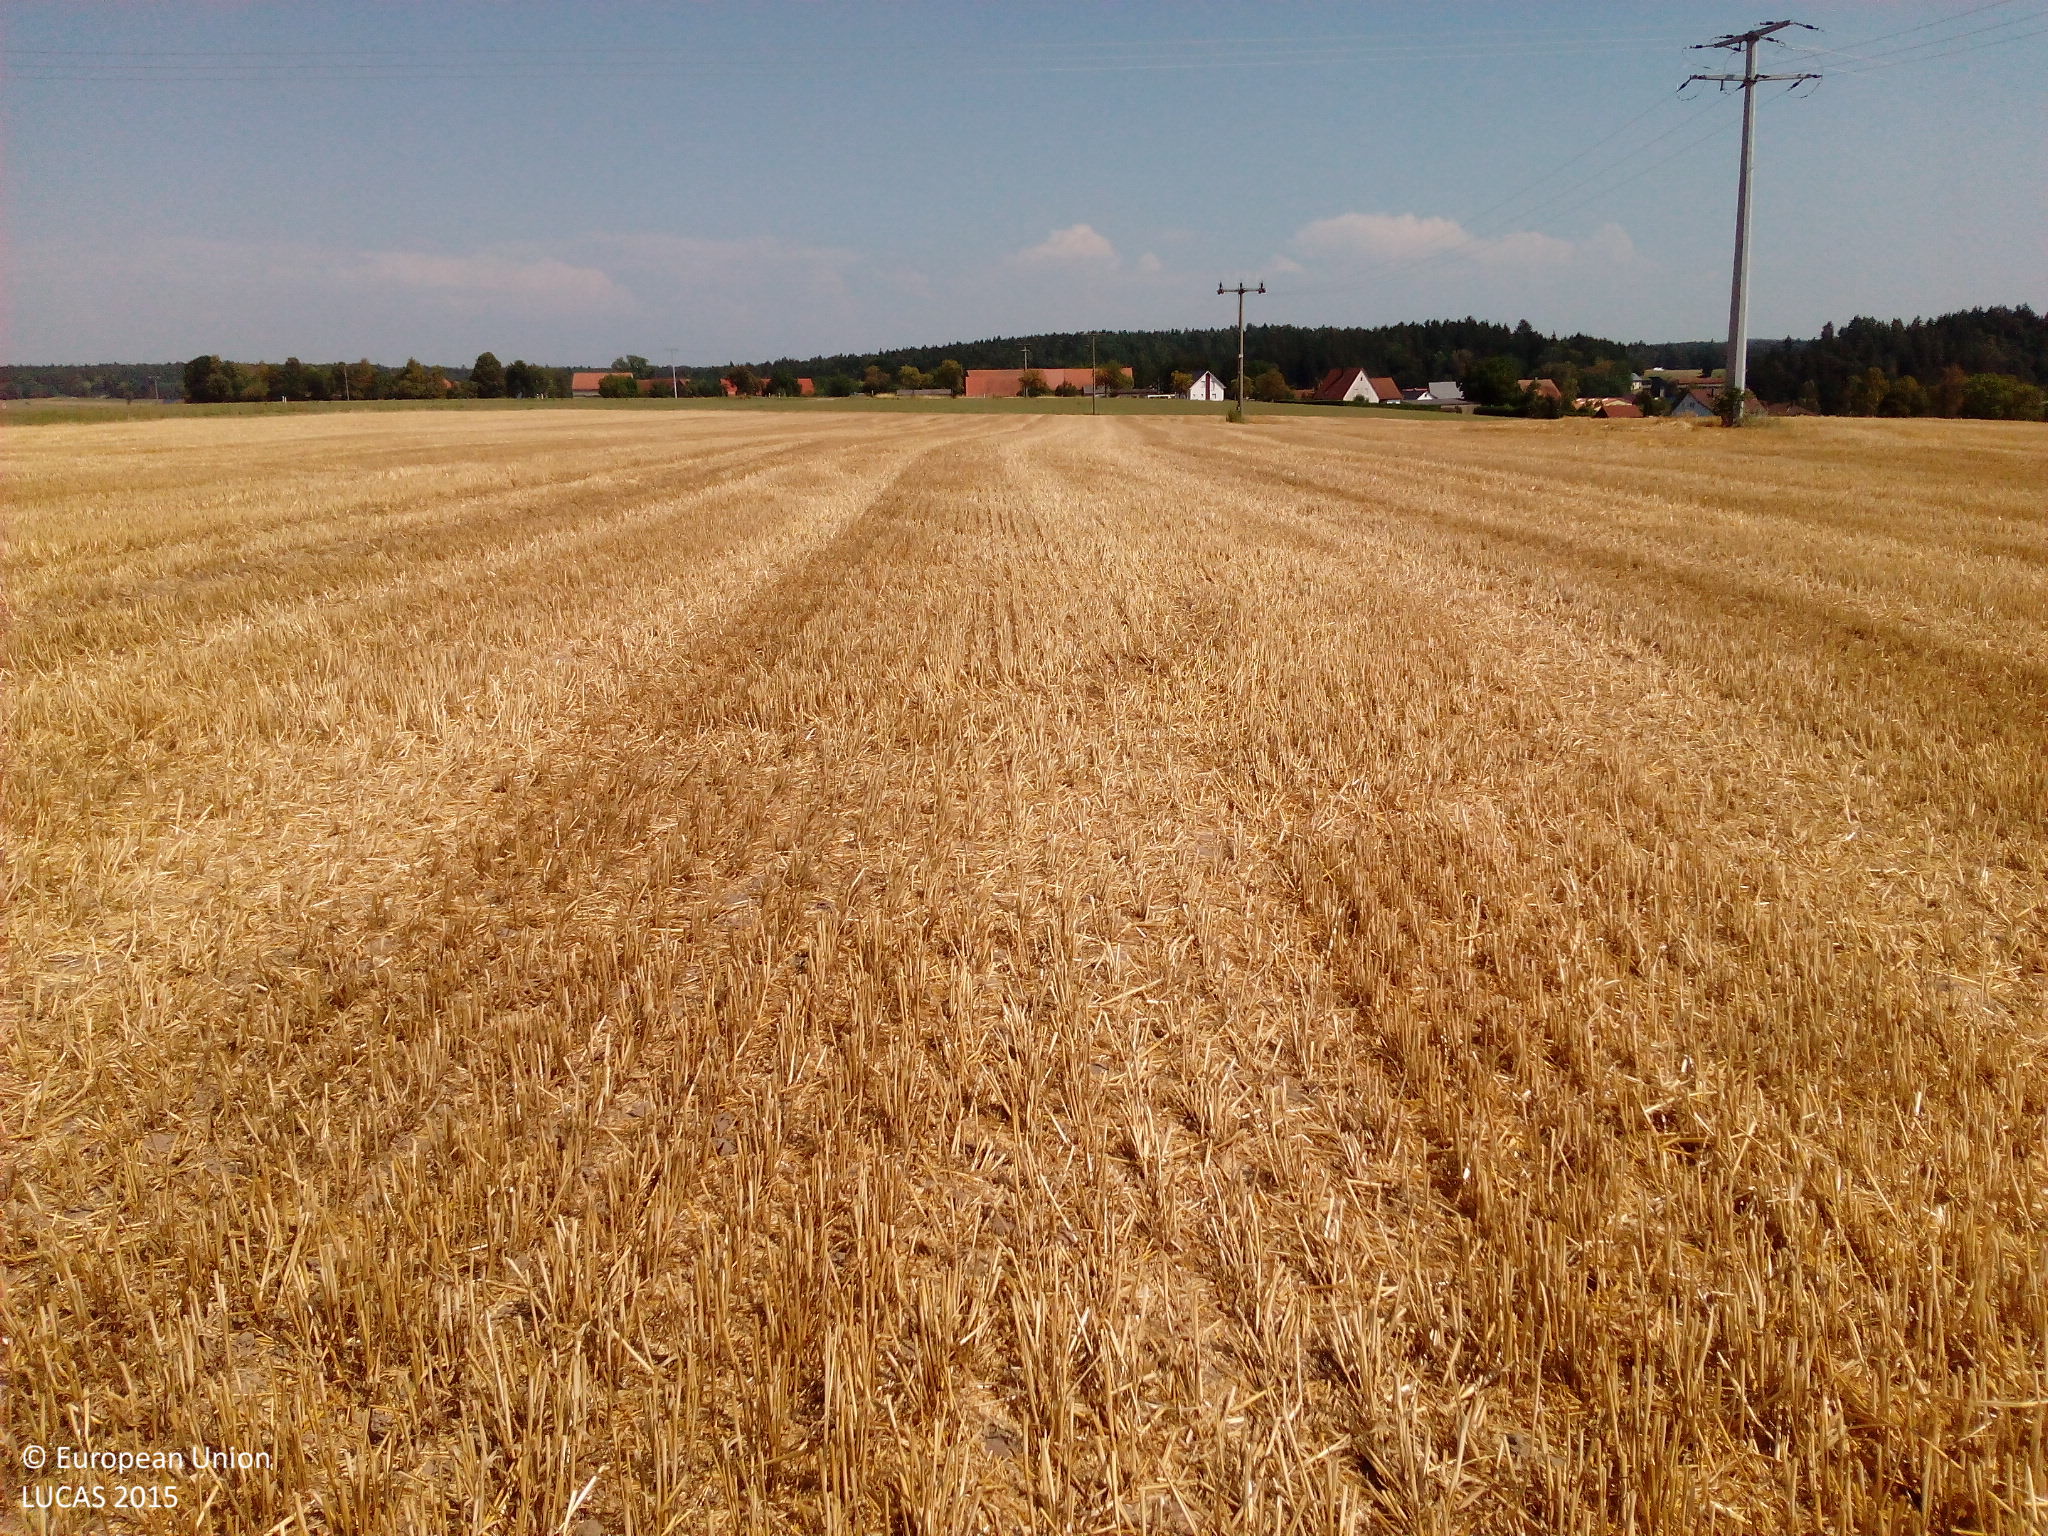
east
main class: Cropland
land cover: Common wheat
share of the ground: < 10 %
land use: Agriculture (excluding fallow land and kitchen gardens)
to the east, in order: Common wheat; Electric lines; Common wheat; Ditches and canals; Grassland without tree/shrub cover
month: August
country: DE
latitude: 49.1047
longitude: 10.3149
